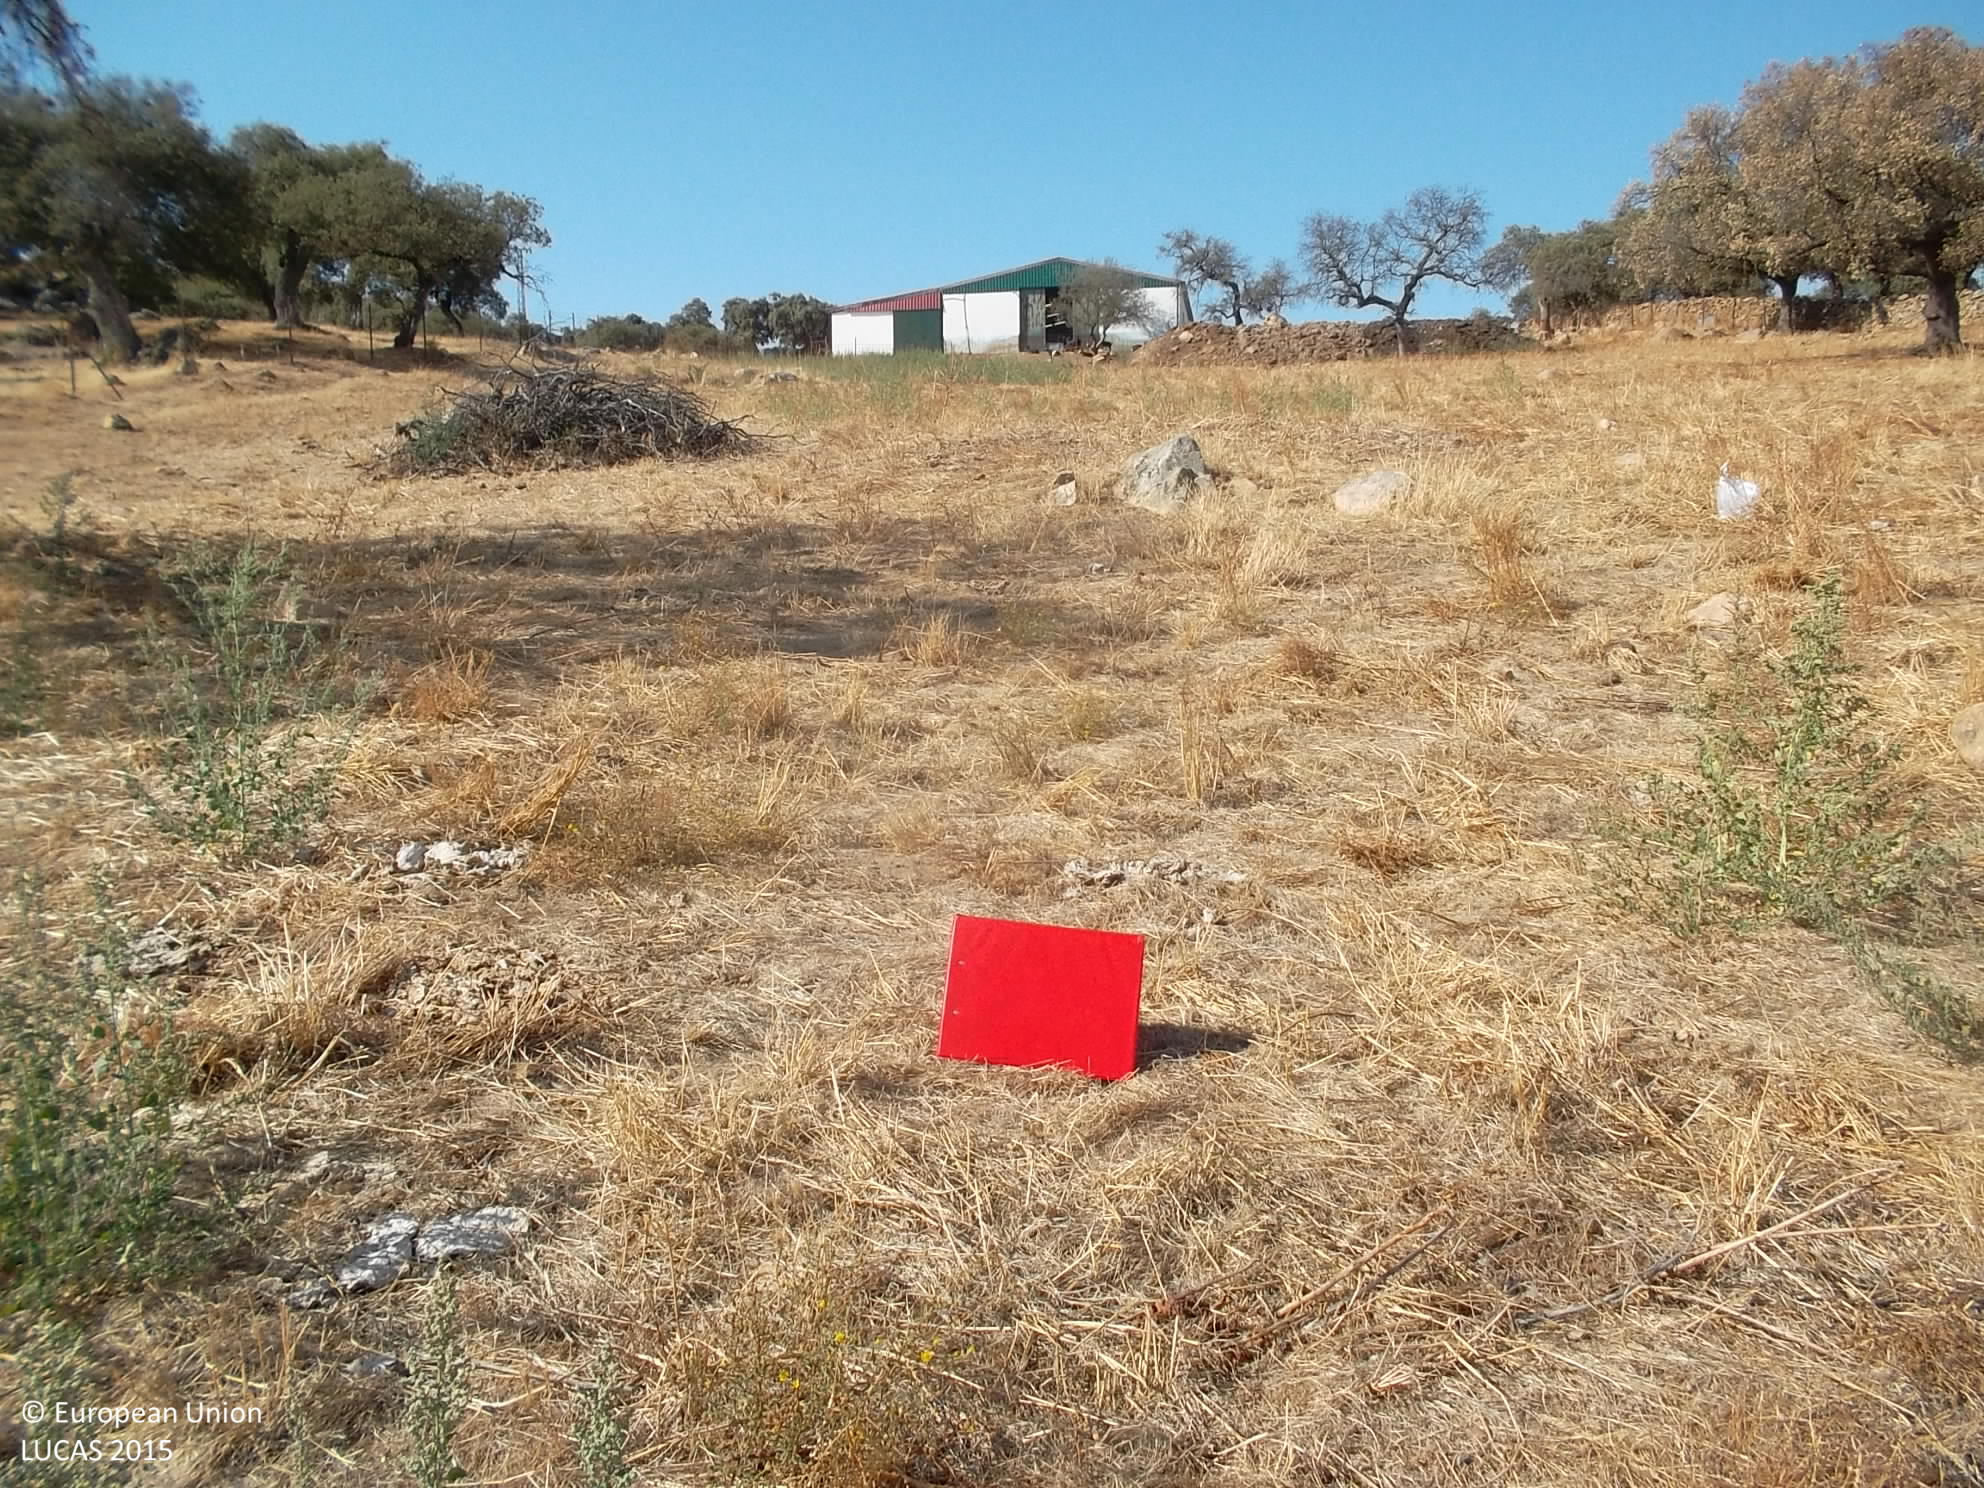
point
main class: Grassland
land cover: Grassland with sparse tree/shrub cover
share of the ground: > 75 %
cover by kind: herbaceous plants 95 %, broadleaved forest trees 5 %
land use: Agriculture (excluding fallow land and kitchen gardens)
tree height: > 5 m
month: September
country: ES
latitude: 38.1128
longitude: -6.3417
